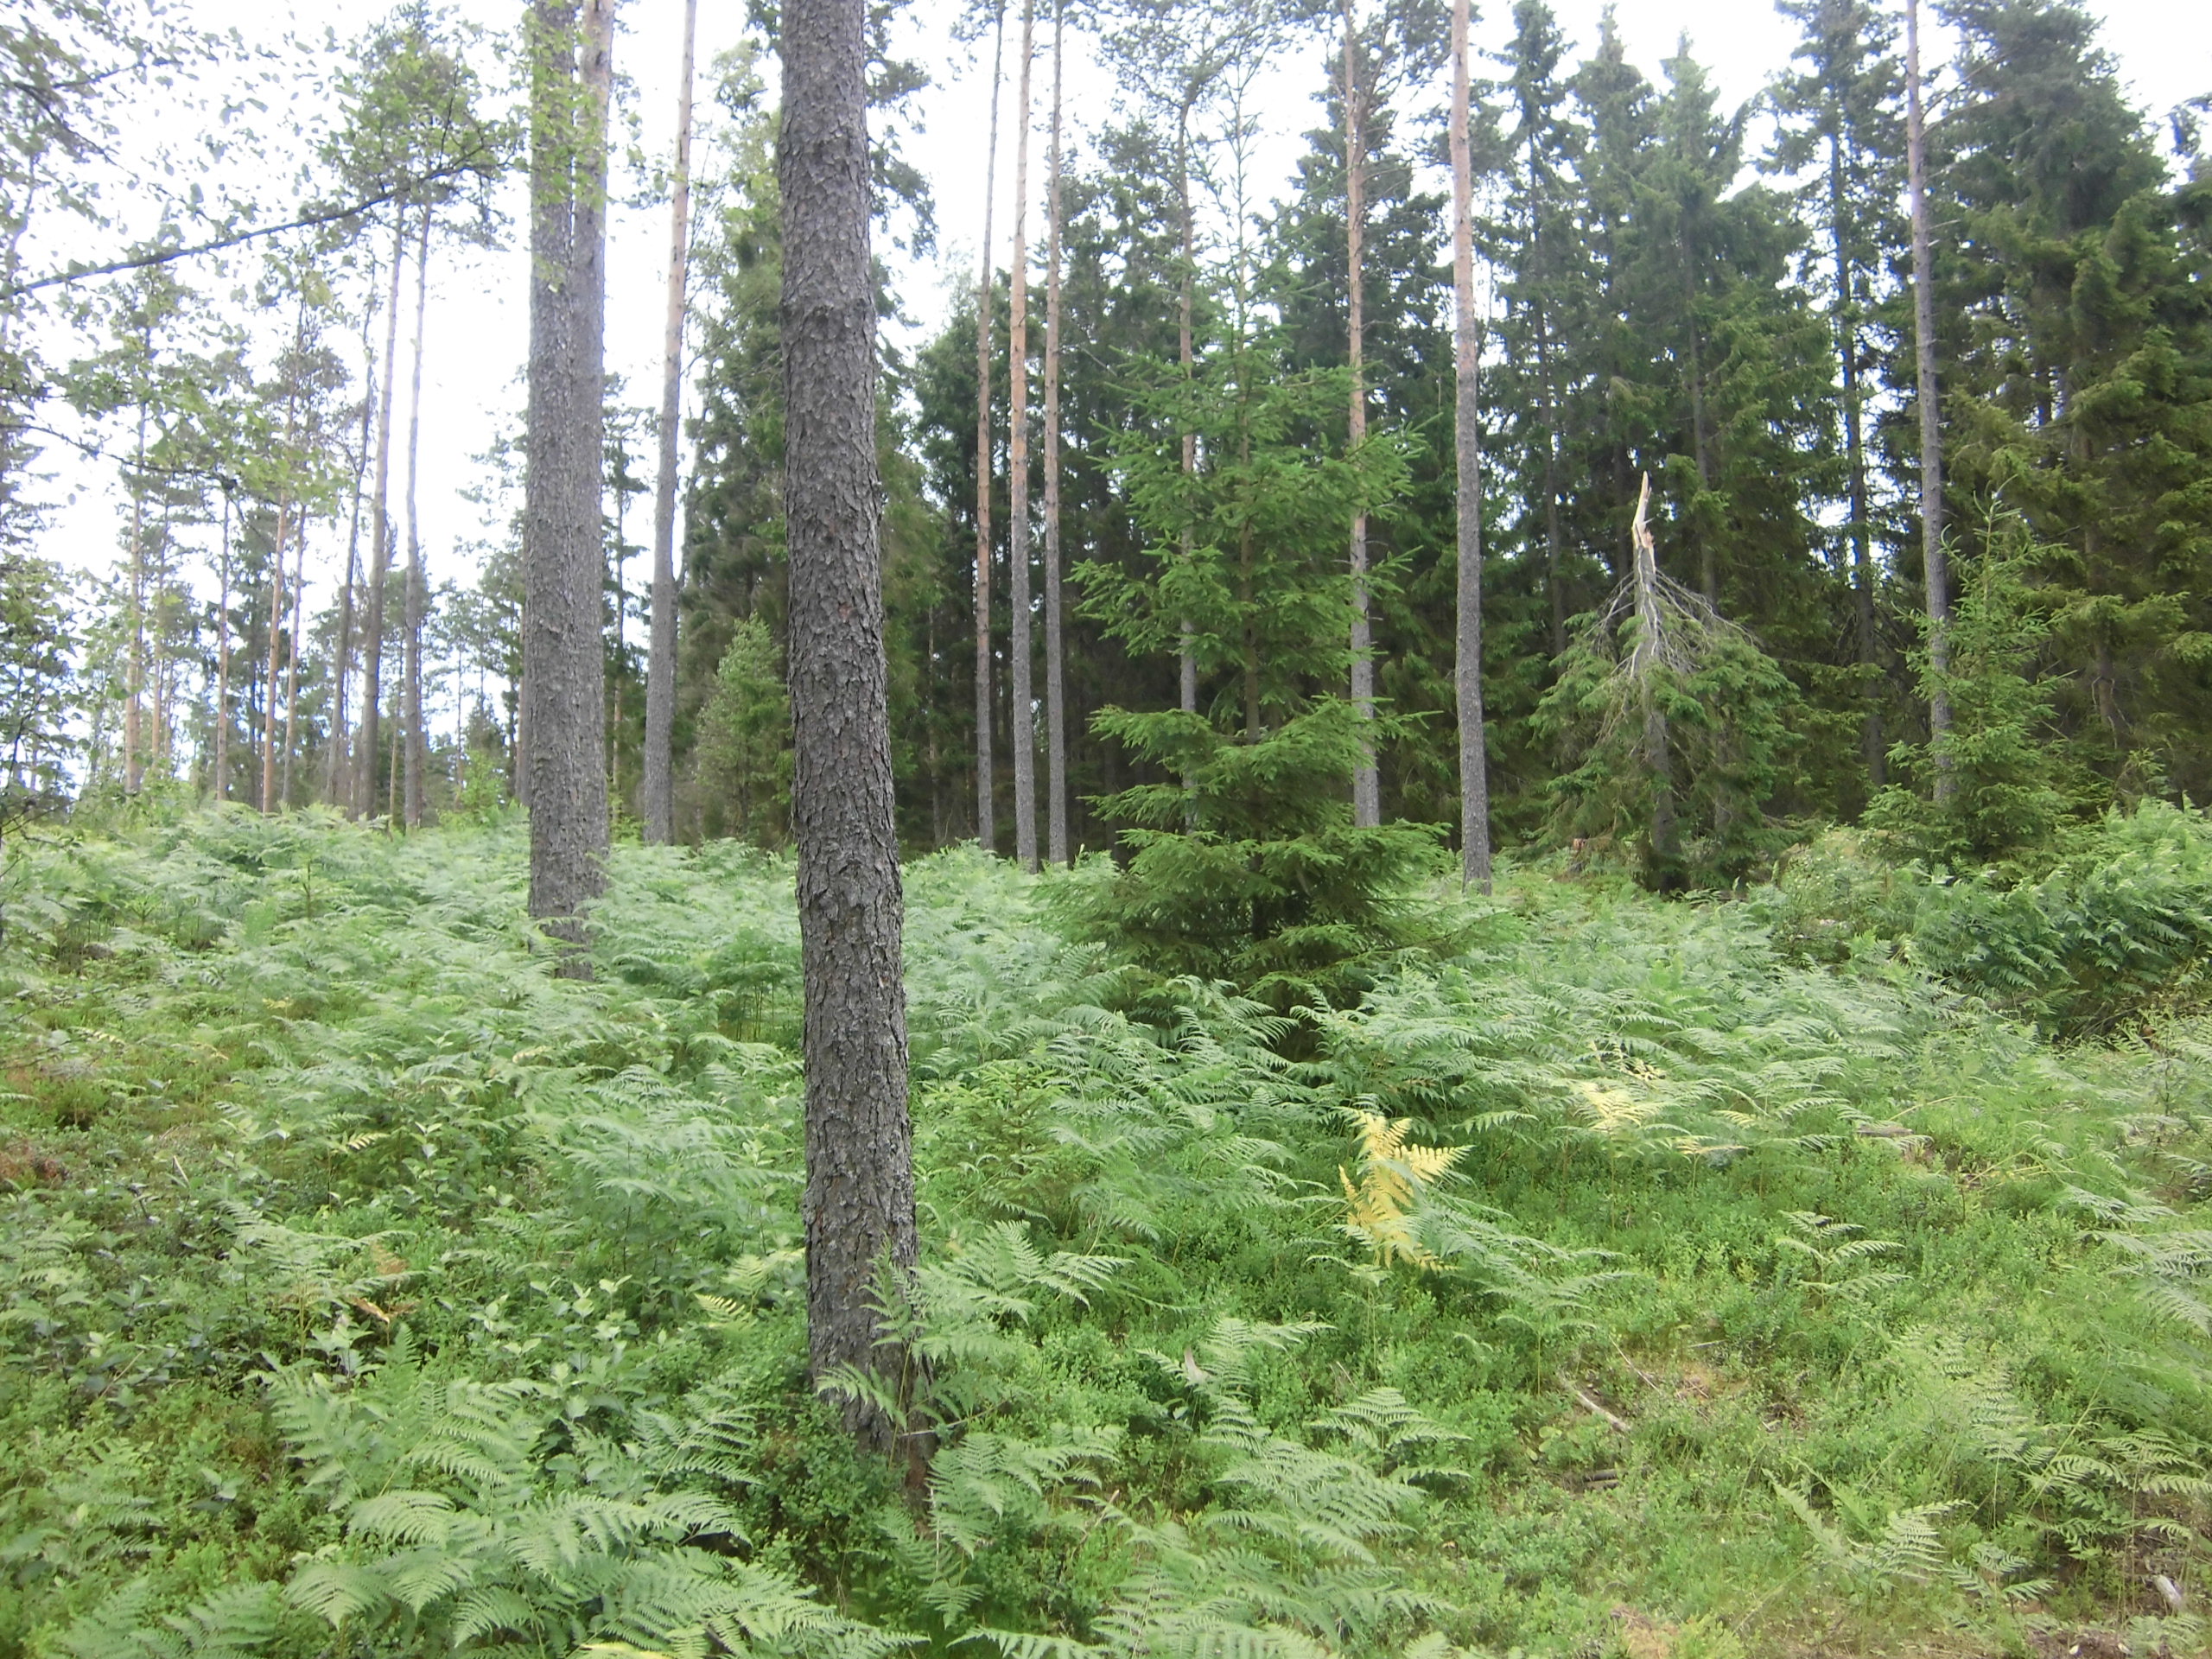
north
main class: Woodland
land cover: Pine dominated coniferous woodland
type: boreal forest
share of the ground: 25 - 50 %
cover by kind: coniferous forest trees 40 %, shrubs 40 %, herbaceous plants 10 %, broadleaved forest trees 5 %, lichens and mosses 5 %
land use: Forestry
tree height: > 5 m
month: July
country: SE
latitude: 57.2749
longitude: 15.1215
